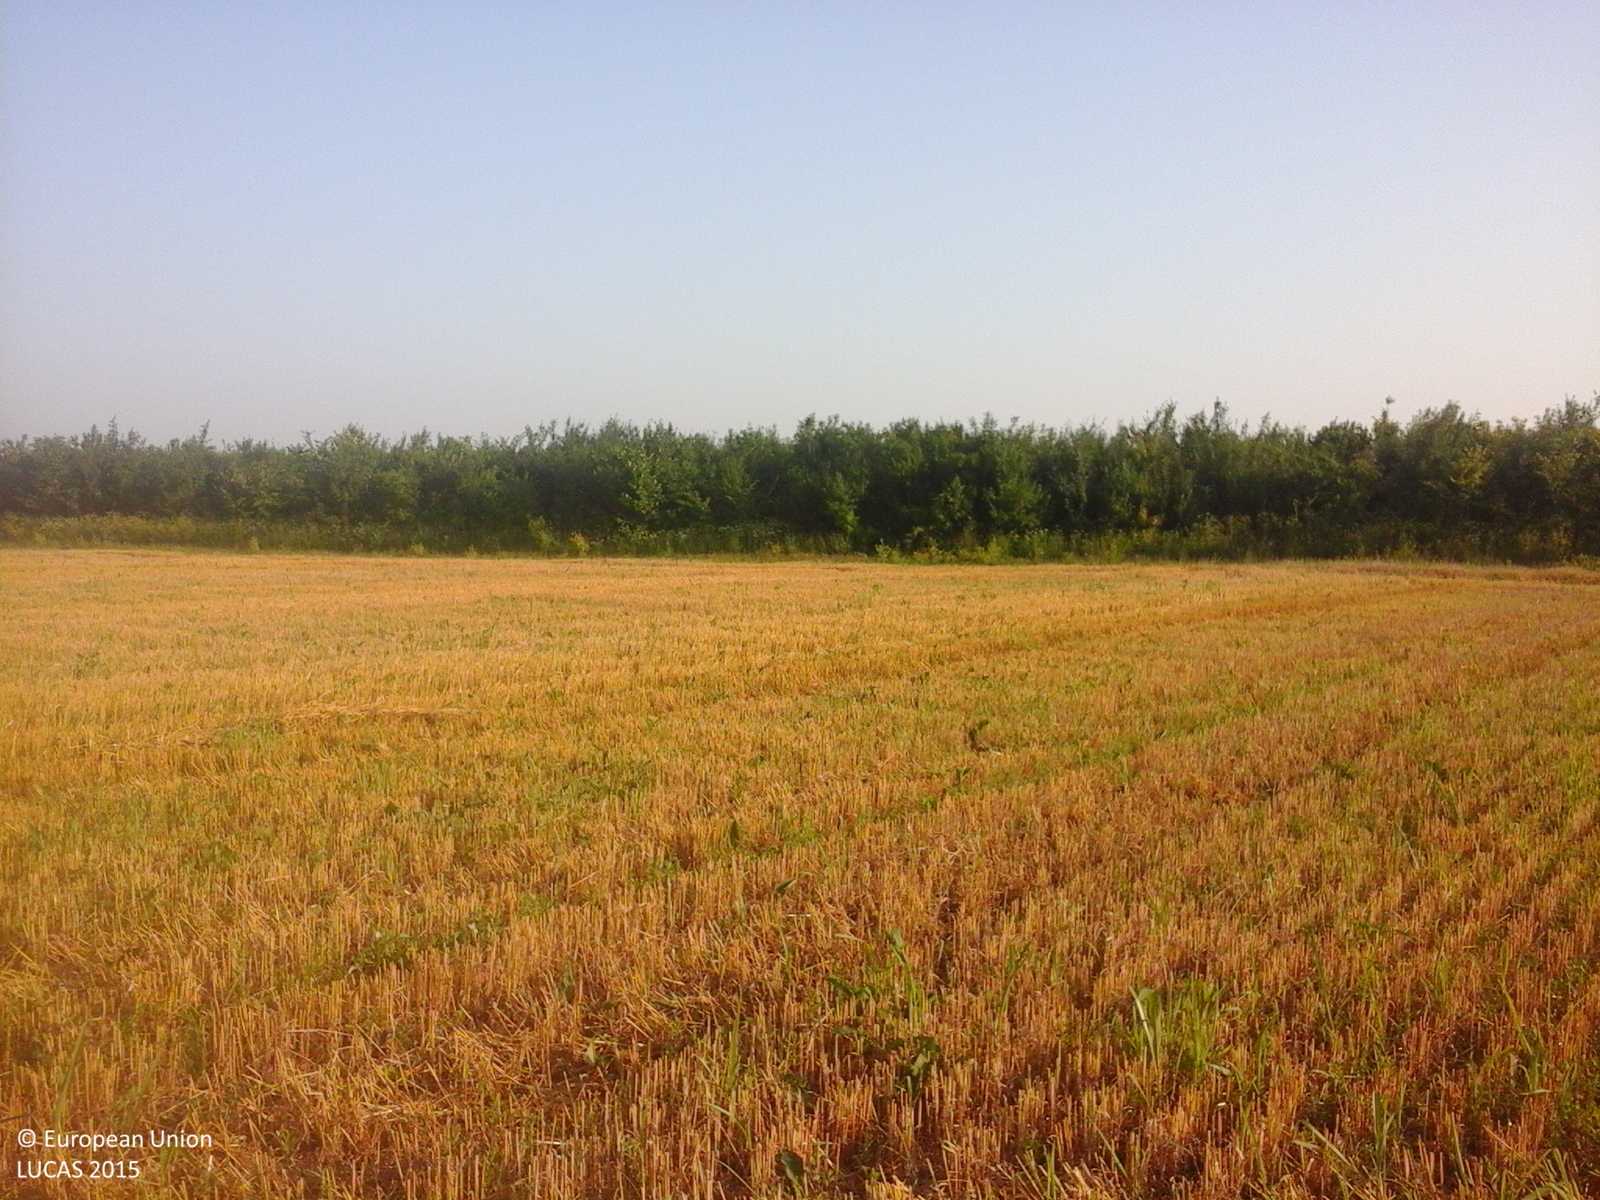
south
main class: Cropland
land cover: Common wheat
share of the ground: 25 - 50 %
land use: Agriculture (excluding fallow land and kitchen gardens)
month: July
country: RO
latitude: 44.6137
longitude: 25.5820
